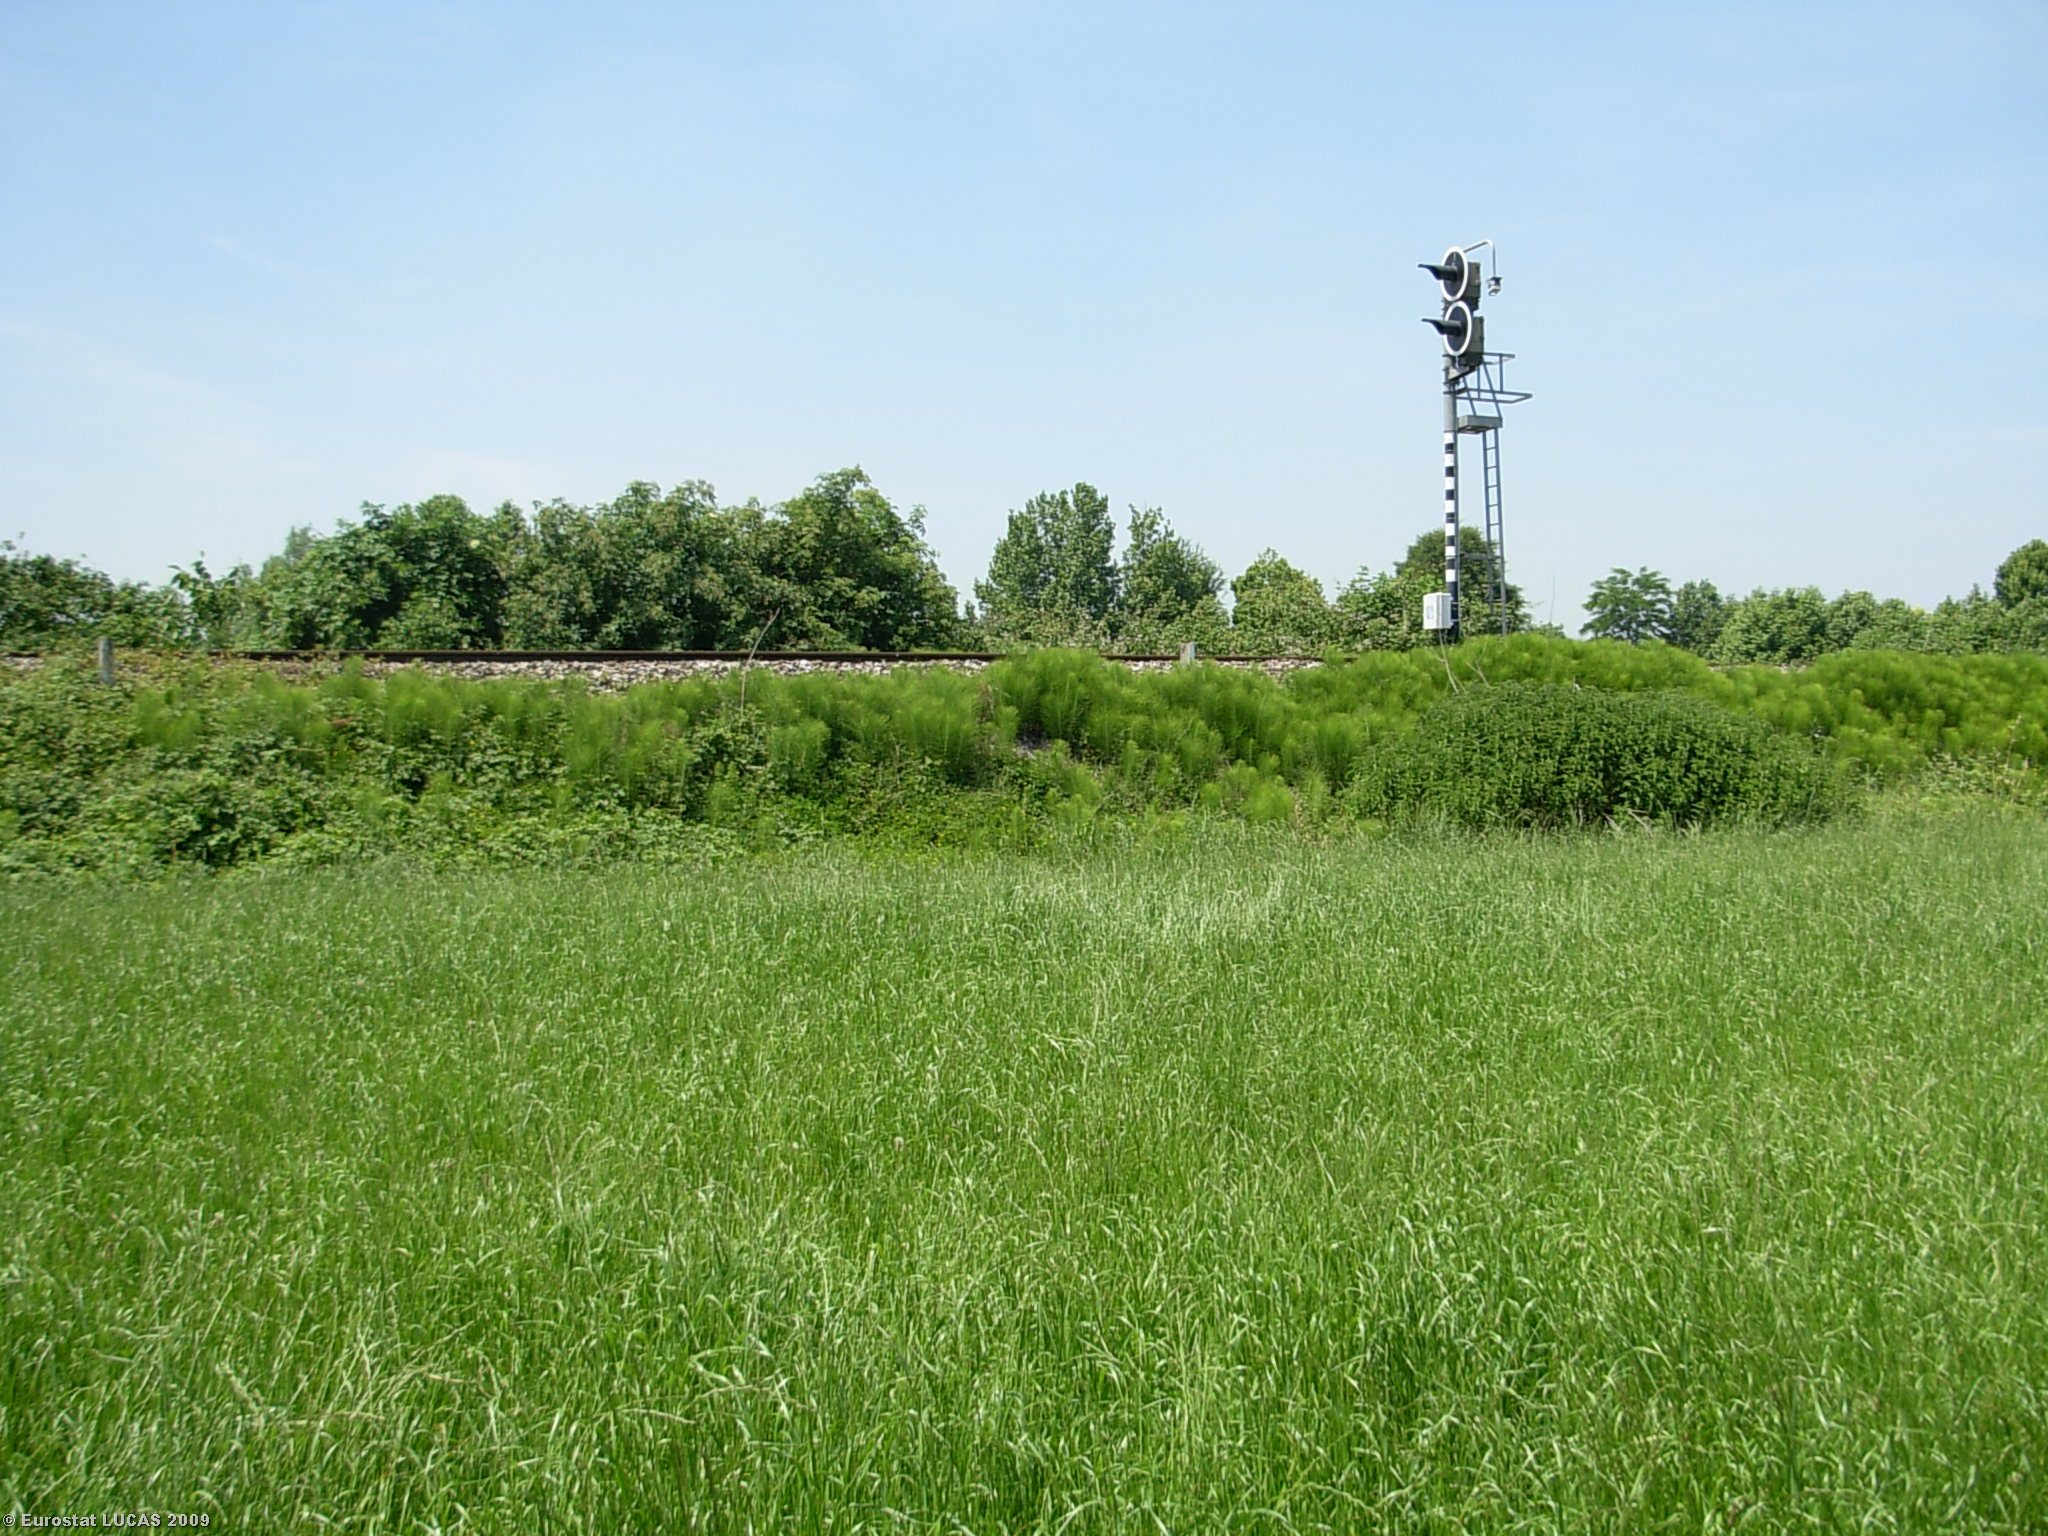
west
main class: Grassland
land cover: Grassland without tree/shrub cover
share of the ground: > 75 %
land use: Agriculture (excluding fallow land and kitchen gardens)
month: June
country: IT
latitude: 45.3597
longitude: 10.3441
